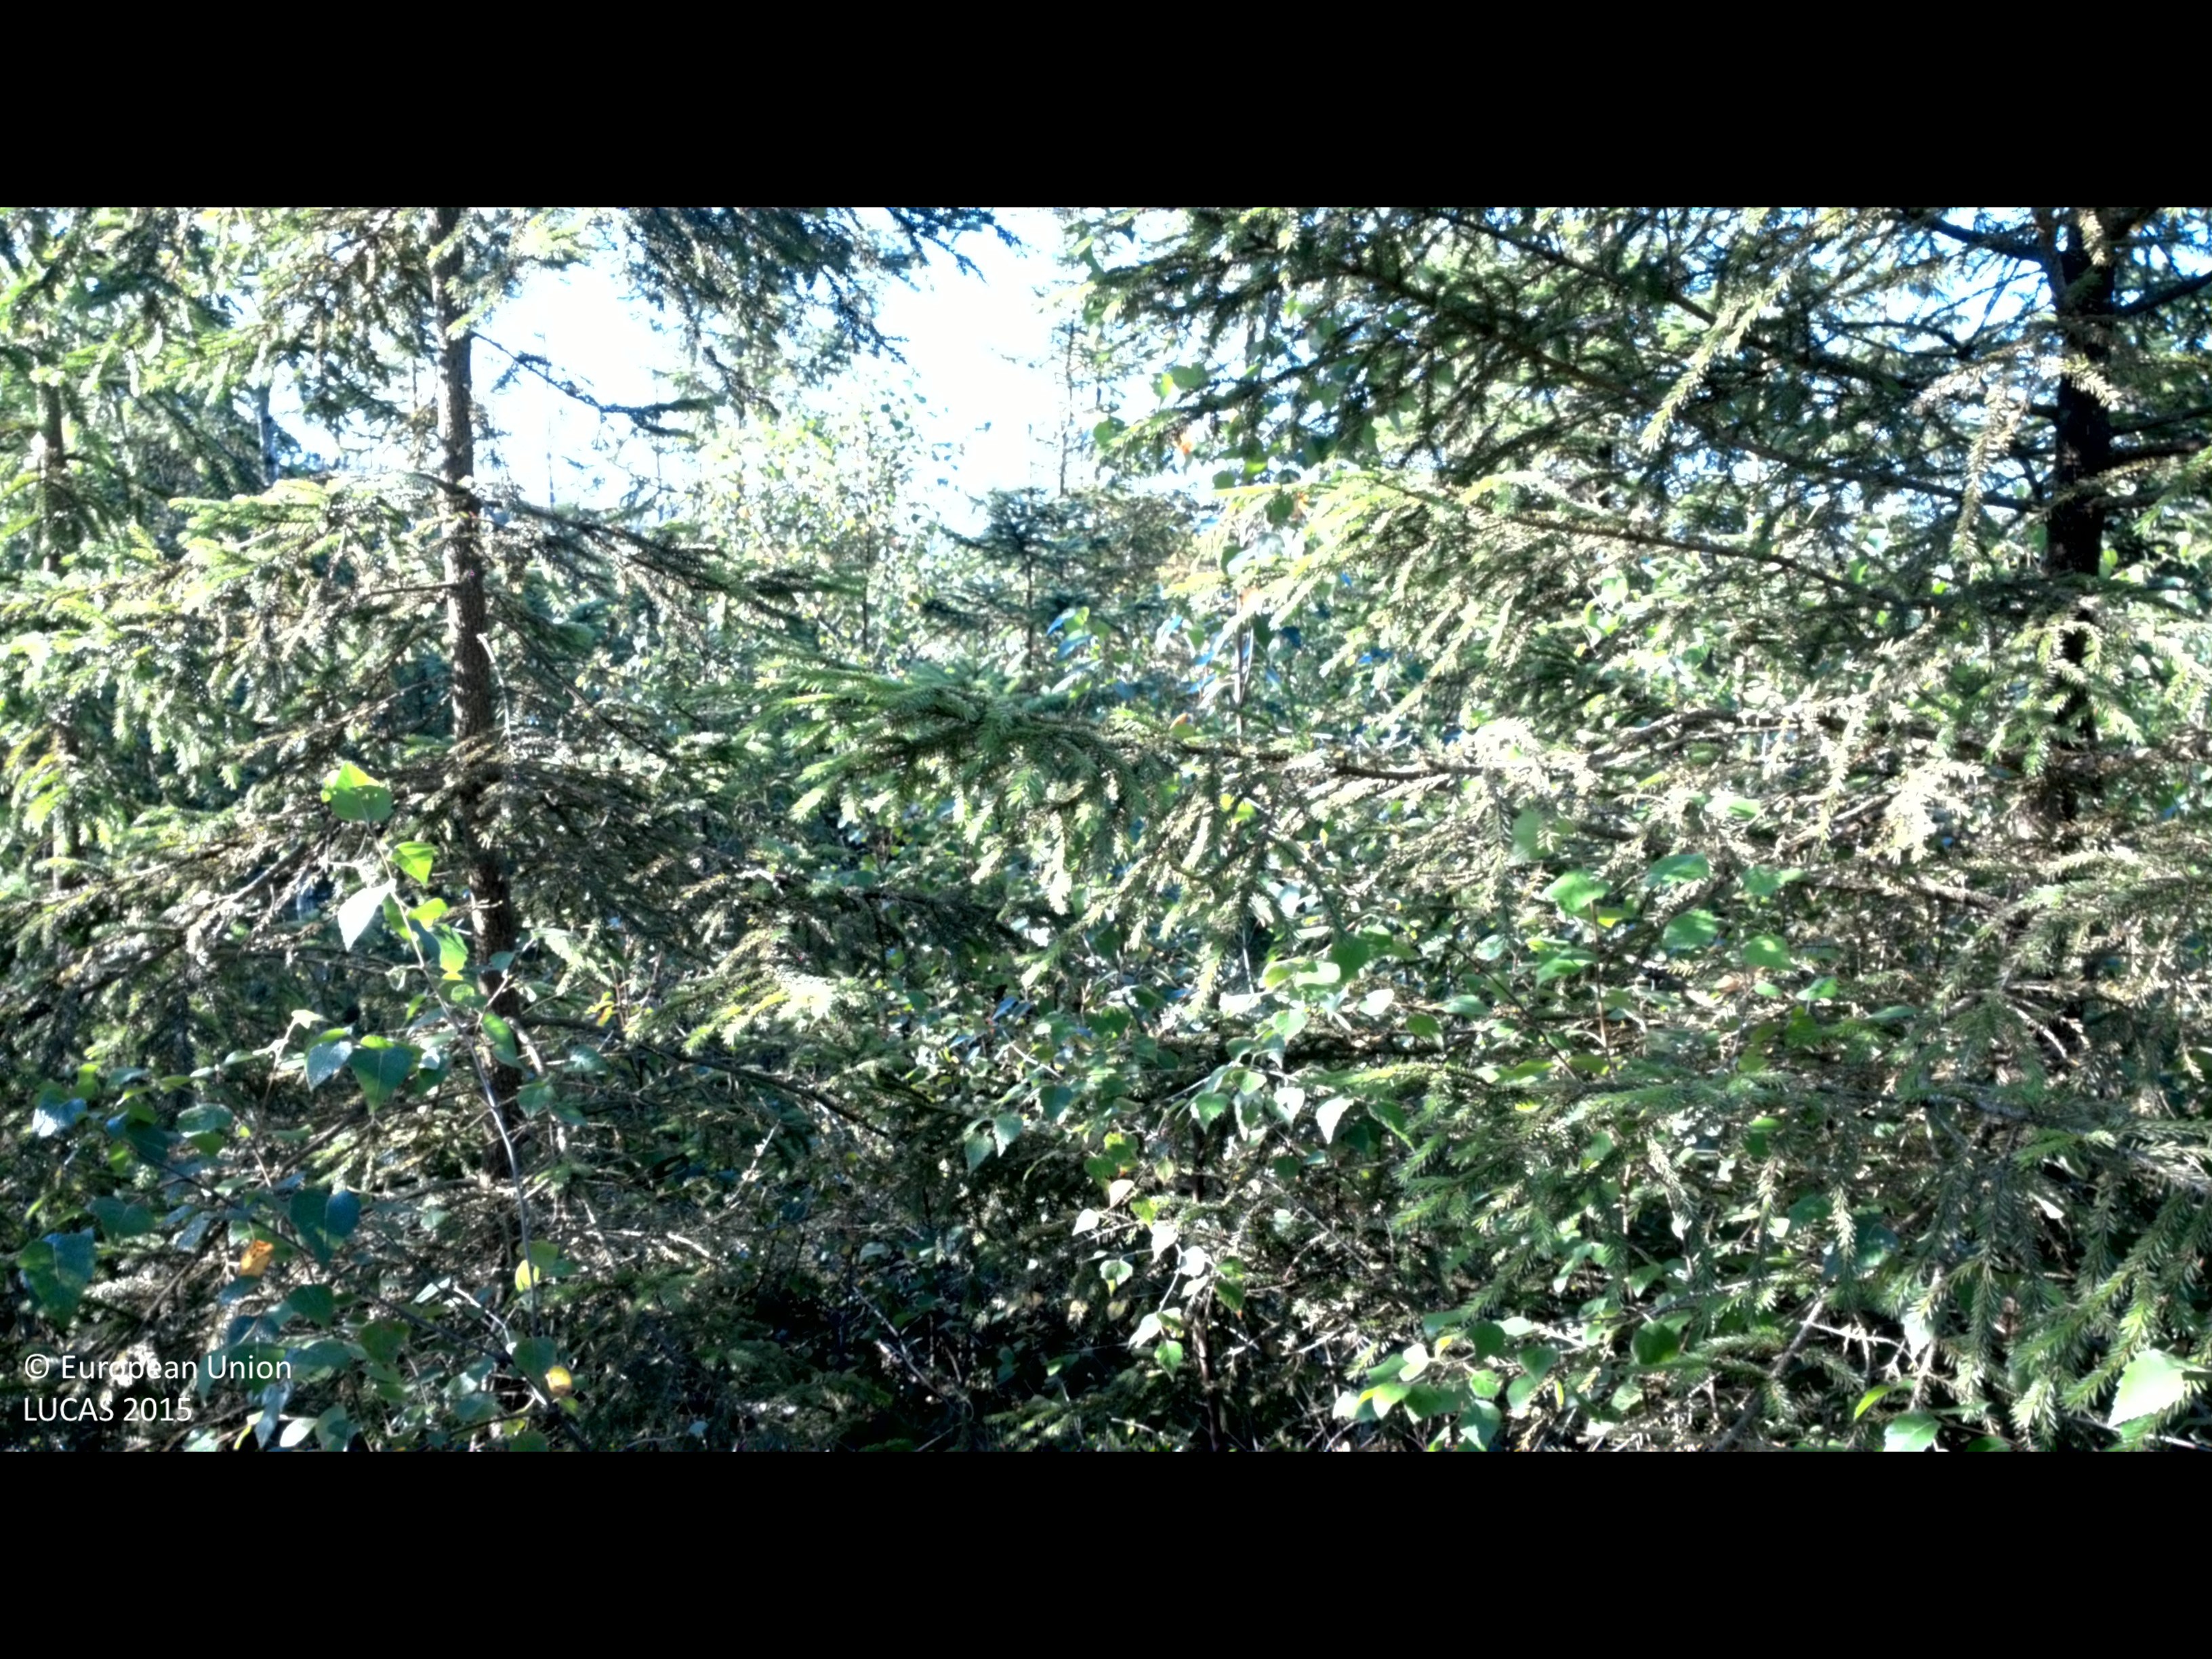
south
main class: Woodland
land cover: Spruce dominated mixed woodland
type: boreal forest
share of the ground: 50 - 75 %
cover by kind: coniferous forest trees 45 %, broadleaved forest trees 30 %, shrubs 25 %
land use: Forestry
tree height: > 5 m
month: August
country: SE
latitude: 56.9567
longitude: 13.2358
